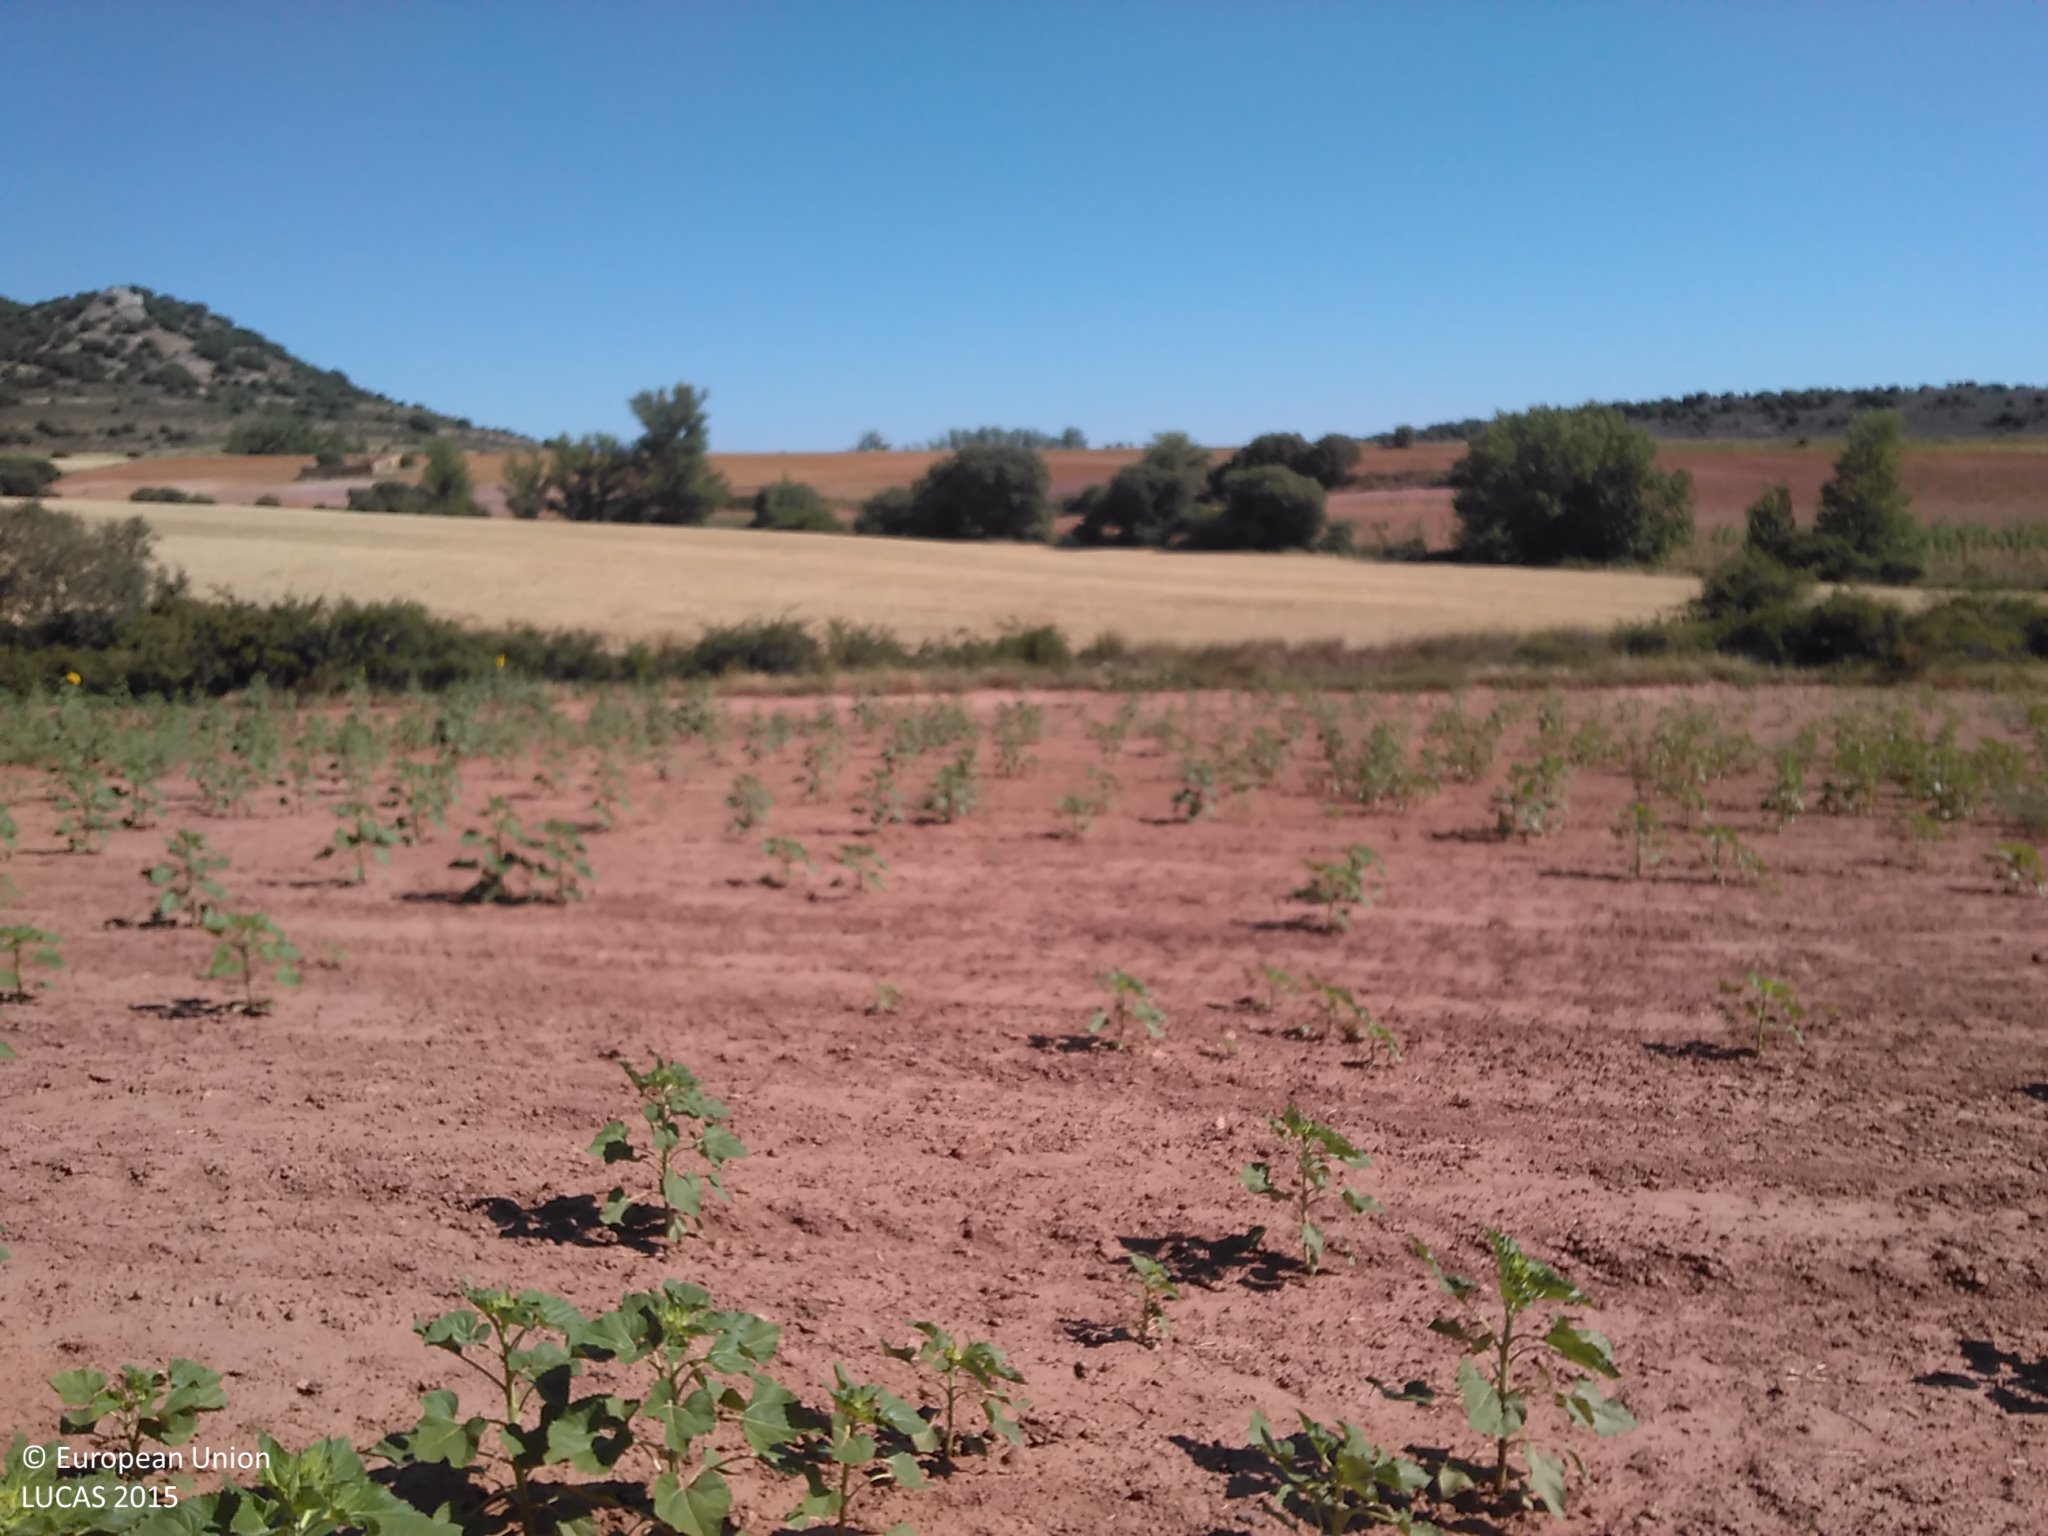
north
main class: Cropland
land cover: Sunflower
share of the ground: 10 - 25 %
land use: Agriculture (excluding fallow land and kitchen gardens)
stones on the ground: < 10 %
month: July
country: ES
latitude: 41.5153
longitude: -2.0249
